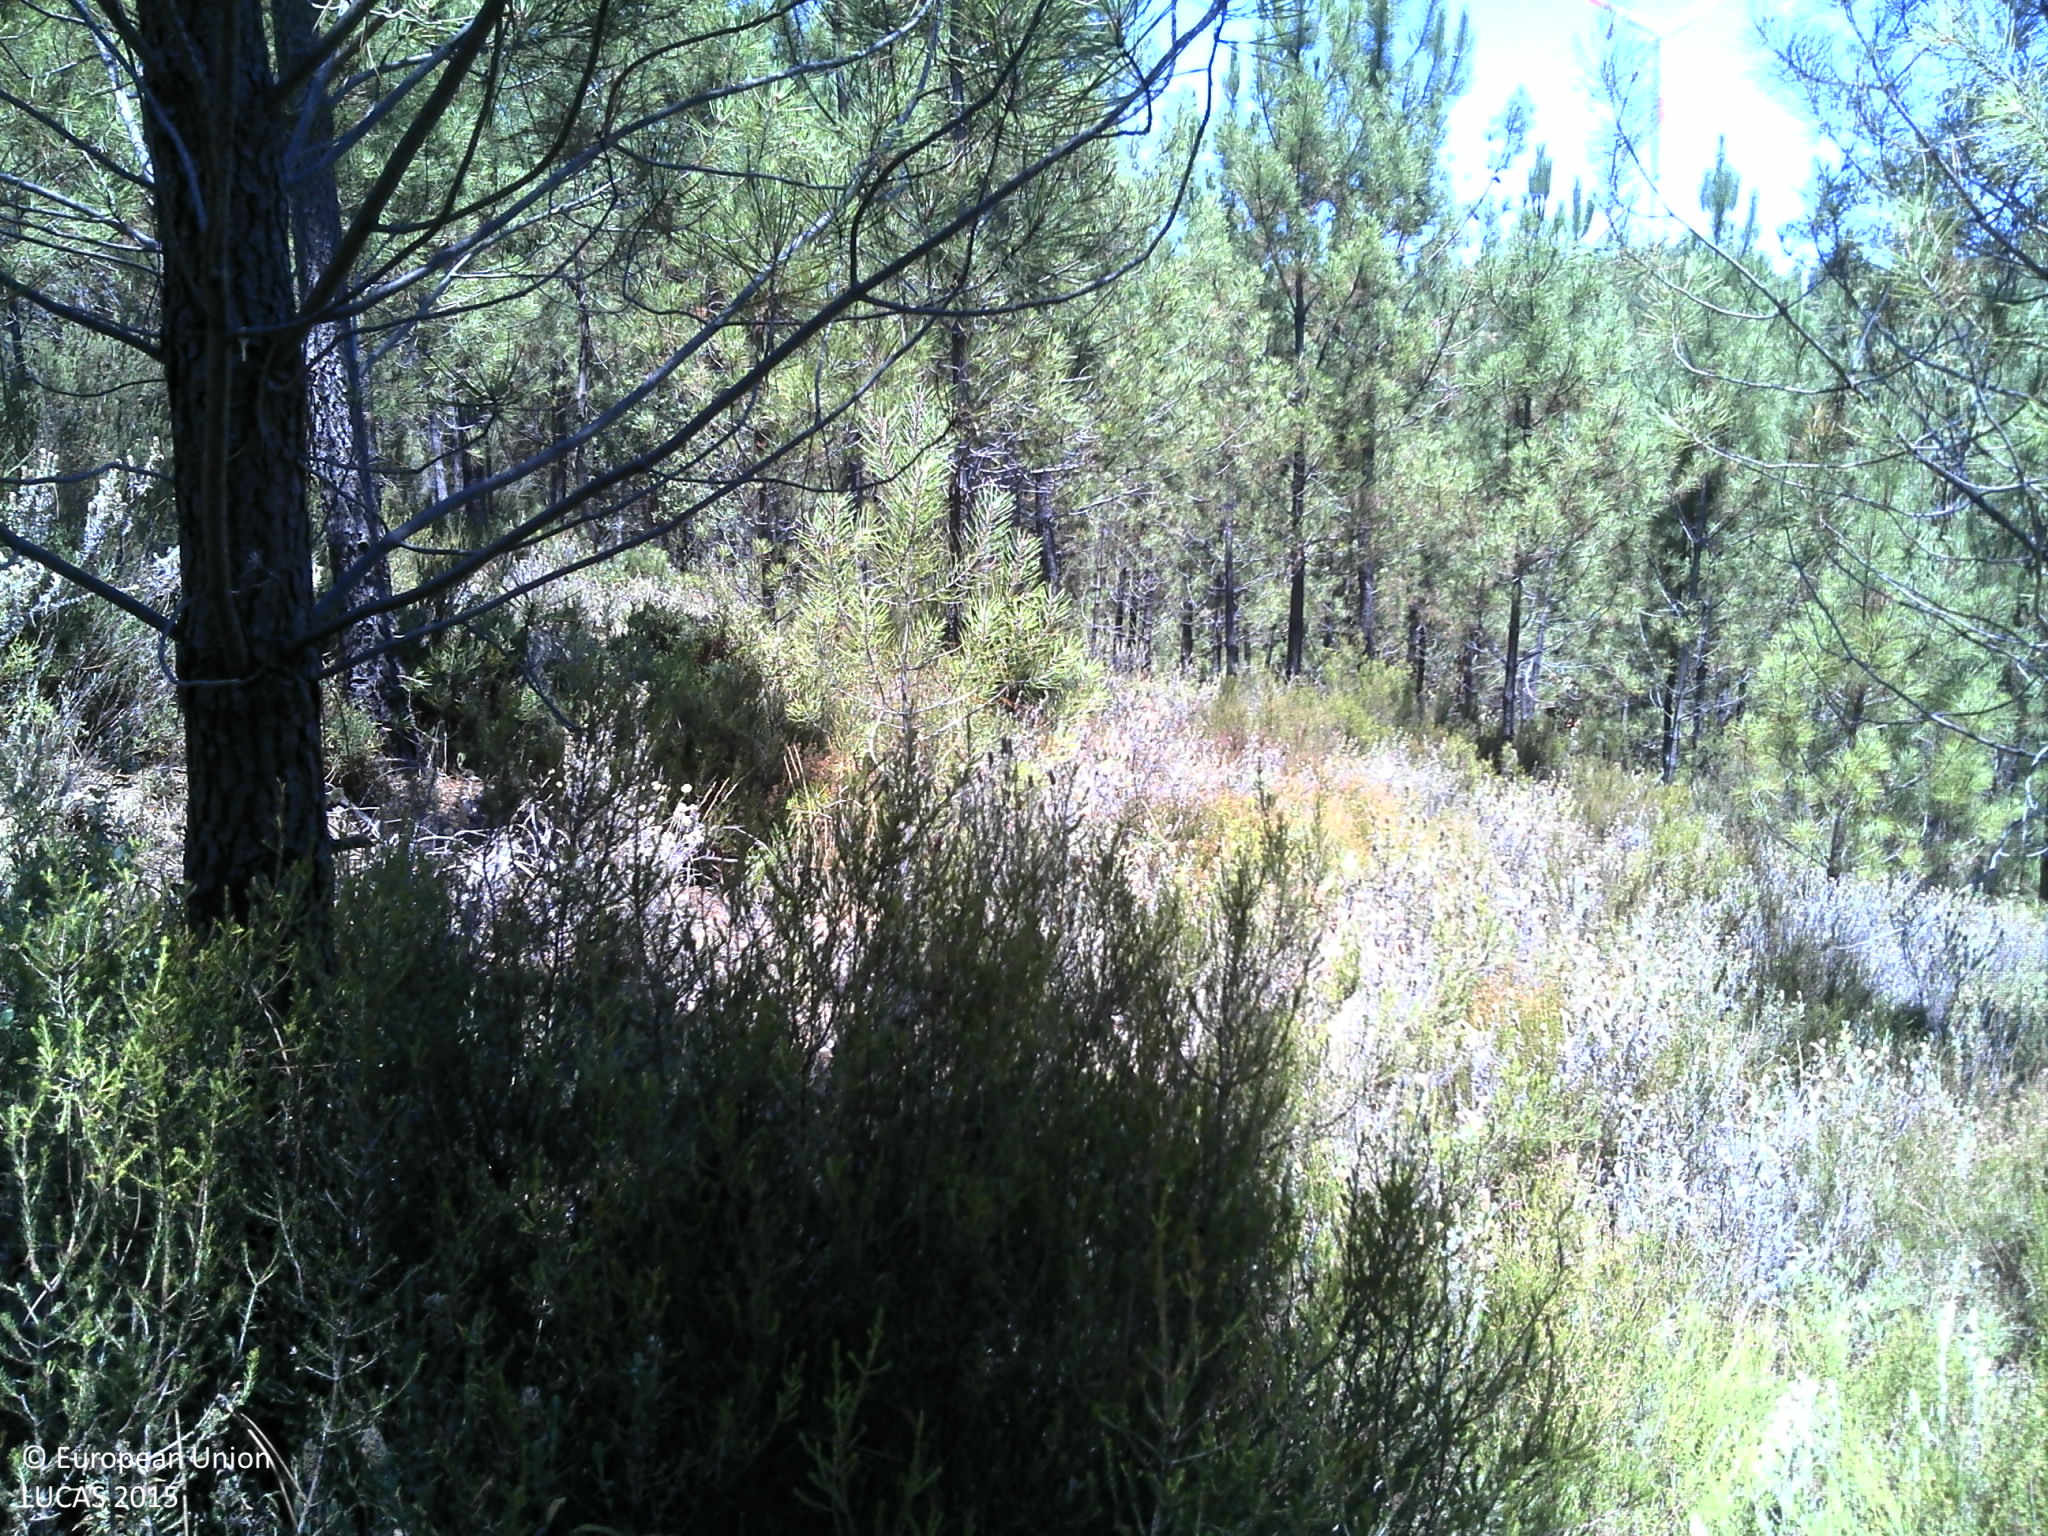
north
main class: Woodland
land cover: Pine dominated coniferous woodland
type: coniferous forest of the mediterranean region
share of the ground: 10 - 25 %
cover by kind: shrubs 85 %, coniferous forest trees 15 %
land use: Forestry
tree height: > 5 m
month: July
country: PT
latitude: 39.7551
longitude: -7.9794
